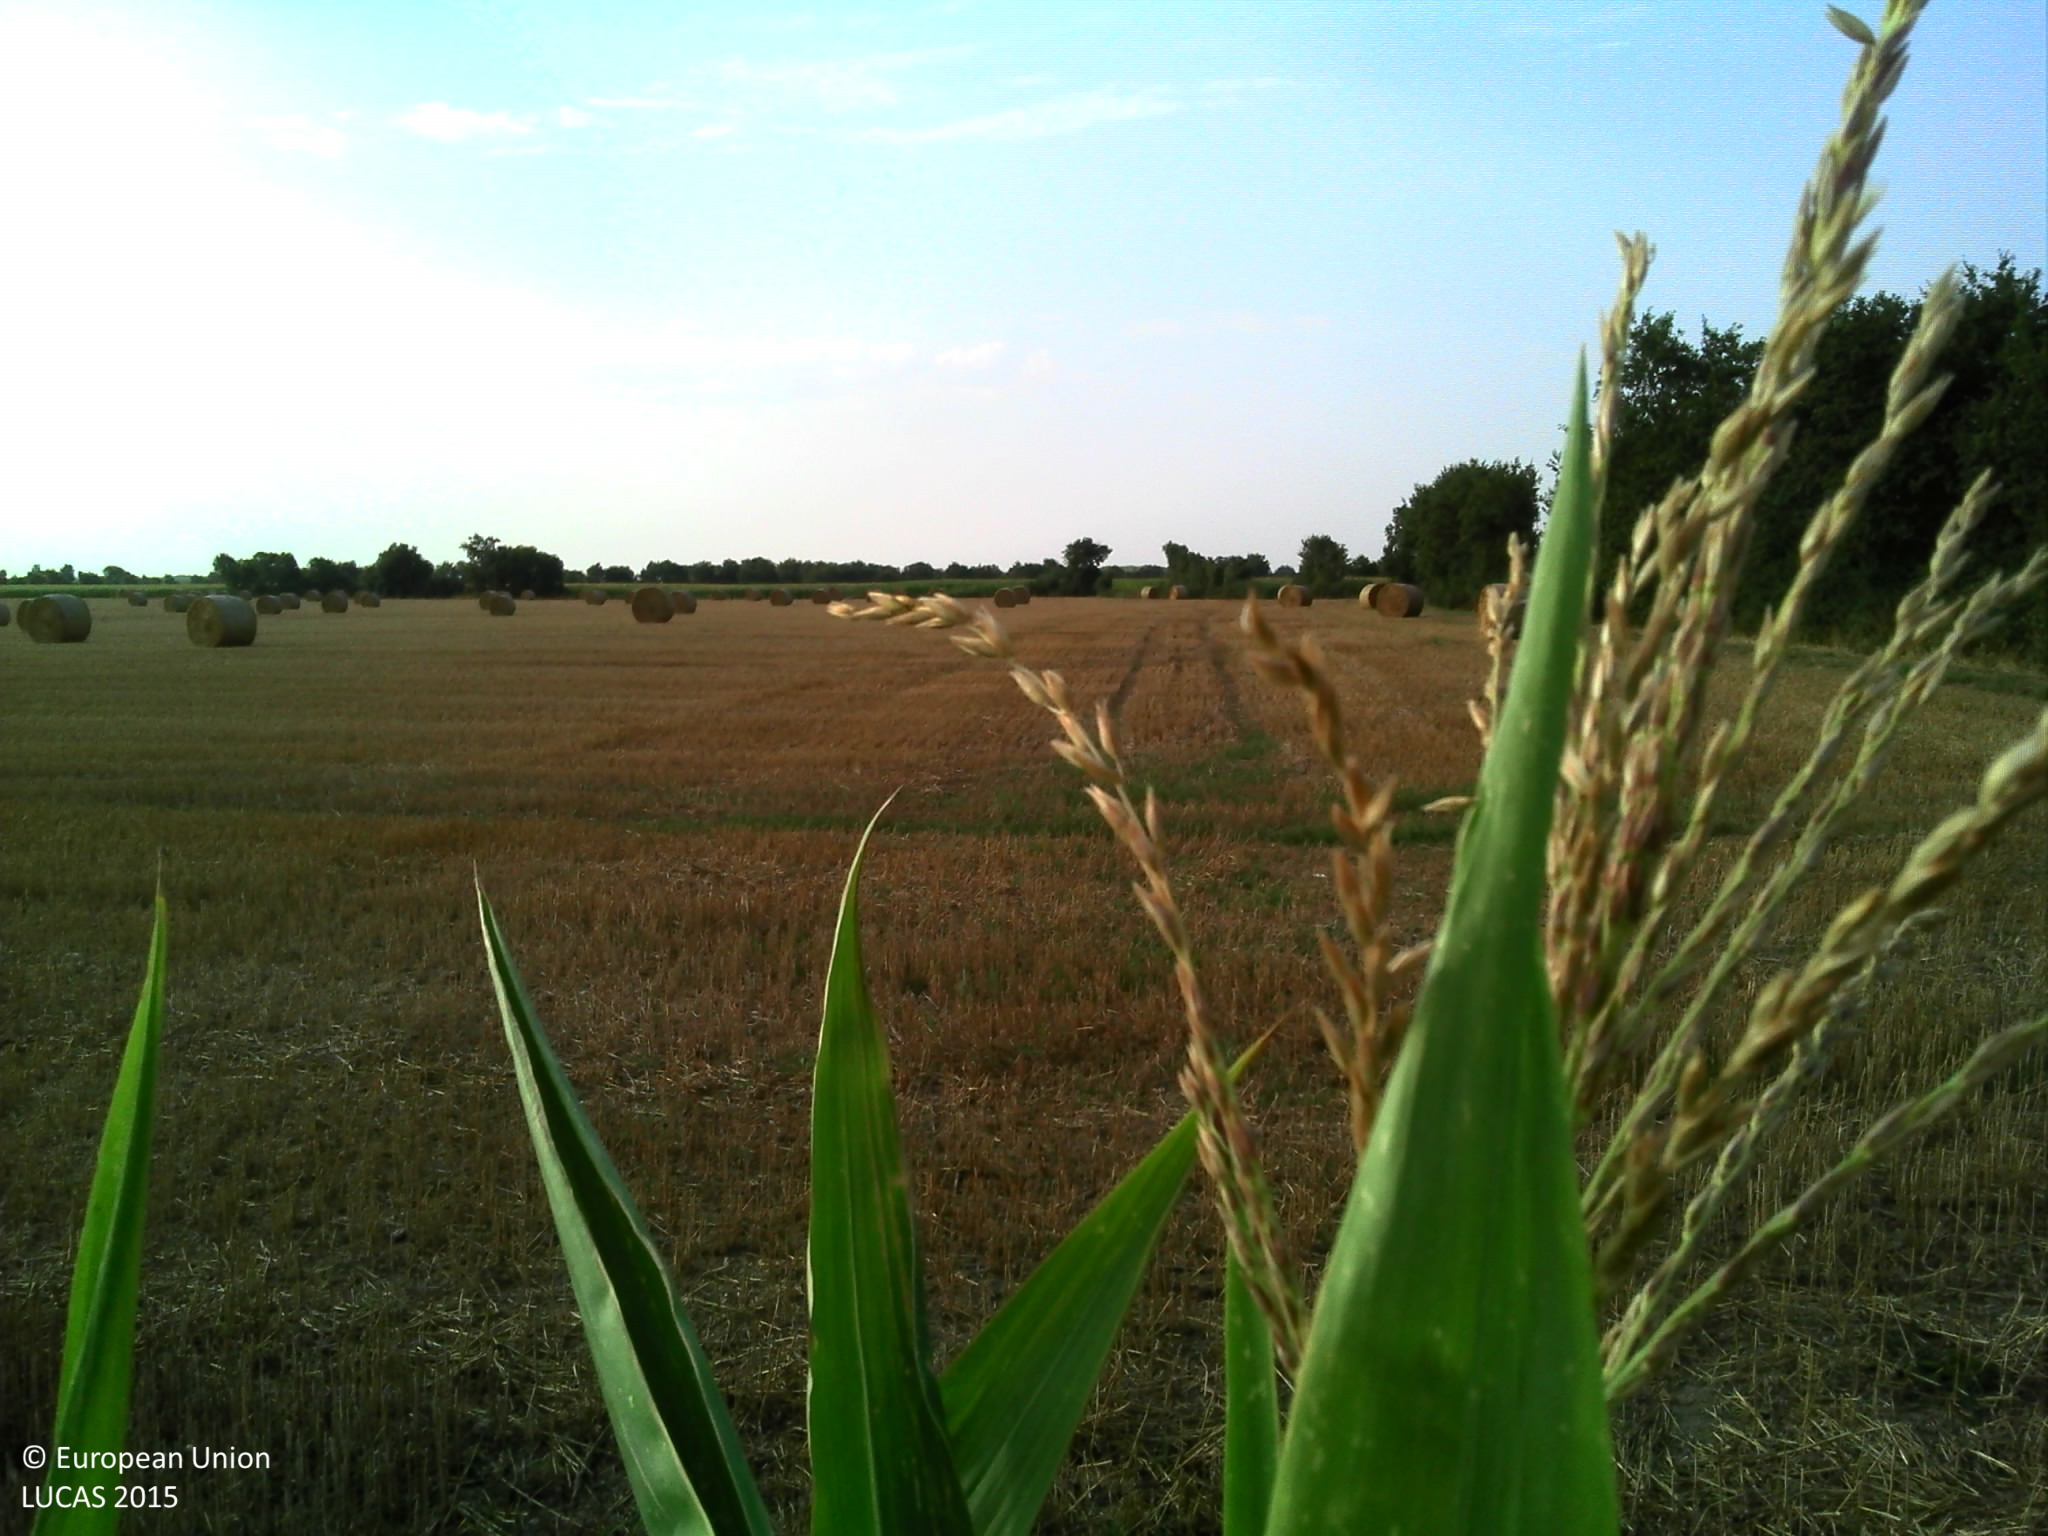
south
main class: Cropland
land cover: Maize
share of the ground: > 75 %
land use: Agriculture (excluding fallow land and kitchen gardens)
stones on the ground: < 10 %
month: August
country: FR
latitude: 46.9618
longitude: -1.6995
